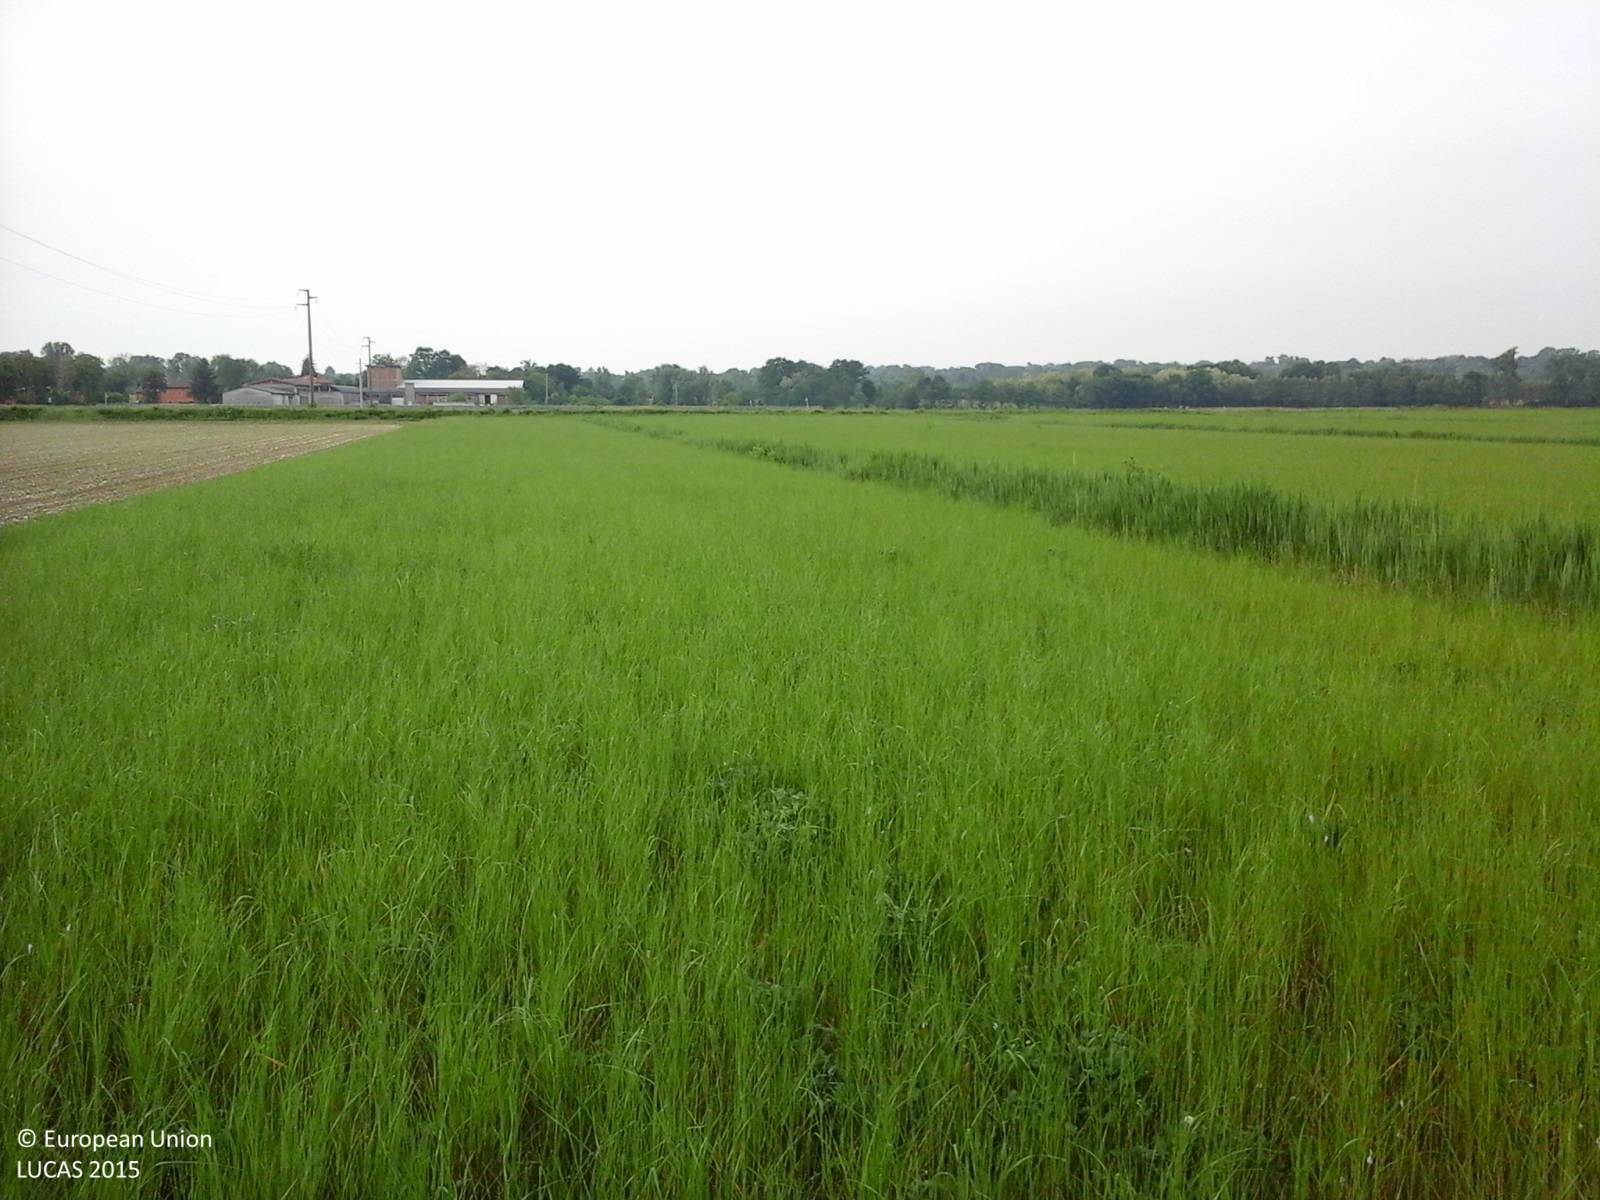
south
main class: Cropland
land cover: Temporary grasslands
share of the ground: > 75 %
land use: Agriculture (excluding fallow land and kitchen gardens)
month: May
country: IT
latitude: 46.1631
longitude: 13.0659
